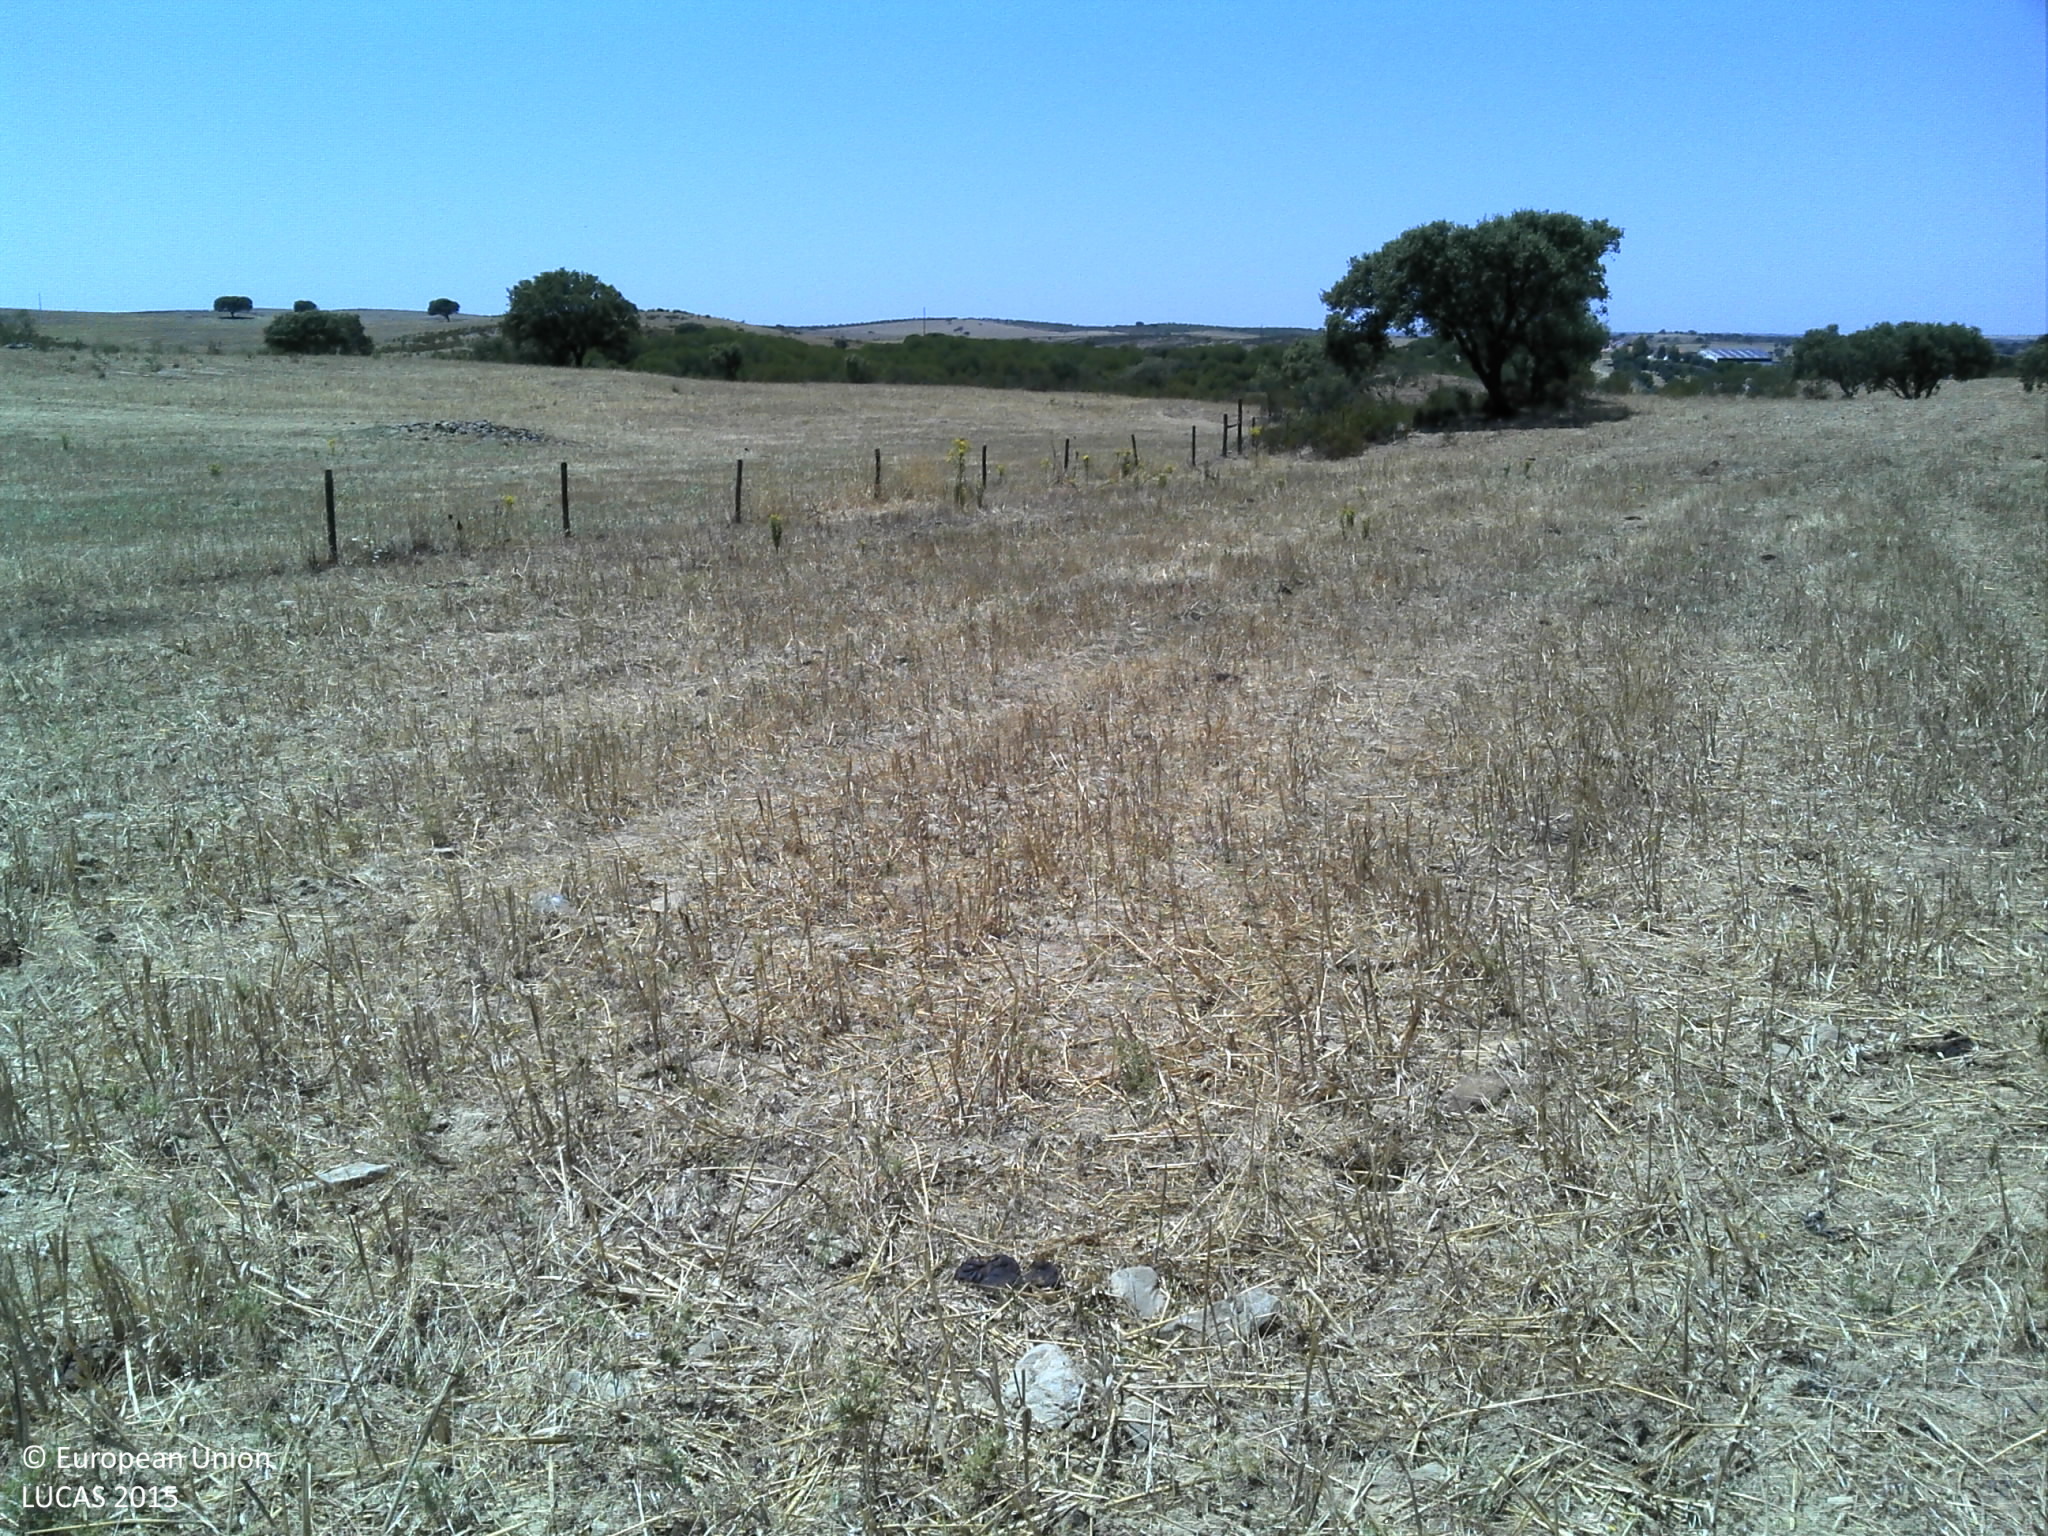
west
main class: Cropland
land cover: Oats
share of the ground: 50 - 75 %
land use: Agriculture (excluding fallow land and kitchen gardens)
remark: Harvested field
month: July
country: PT
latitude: 37.5047
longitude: -7.8566
